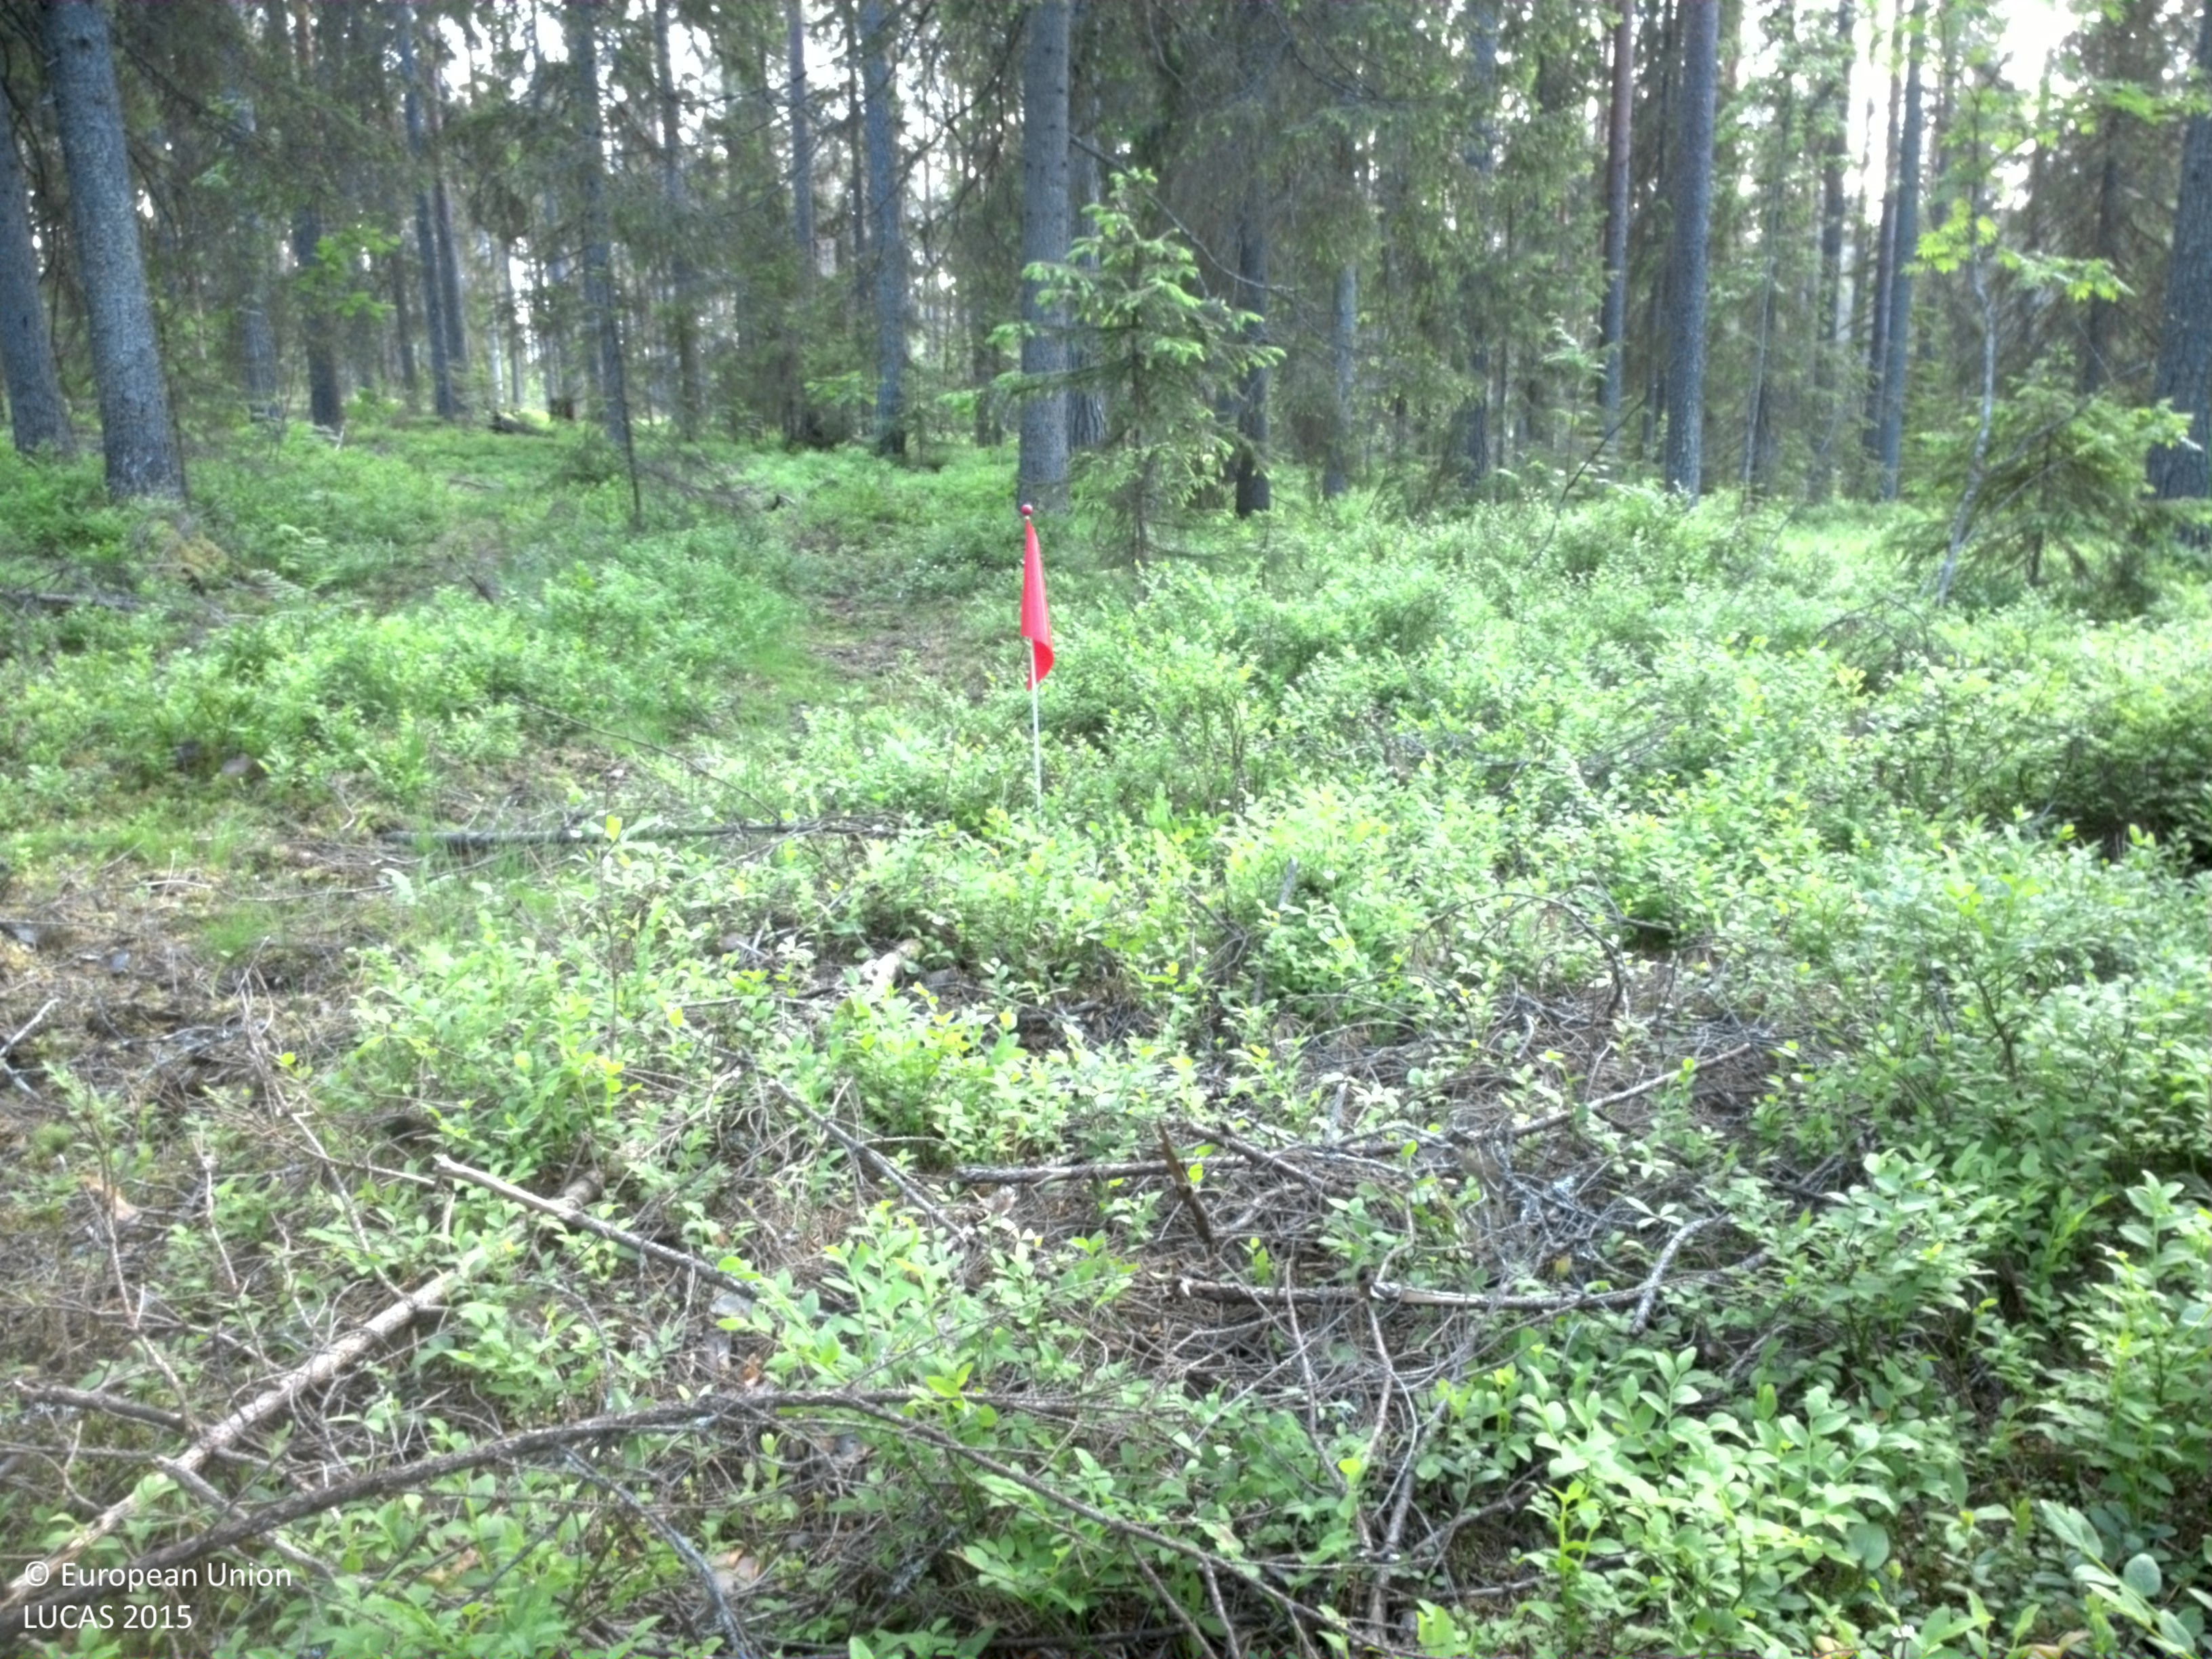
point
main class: Woodland
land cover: Pine dominated coniferous woodland
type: boreal forest
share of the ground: 25 - 50 %
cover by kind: shrubs 60 %, coniferous forest trees 40 %
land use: Forestry
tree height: > 5 m
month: June
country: SE
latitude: 66.3229
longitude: 22.7639
